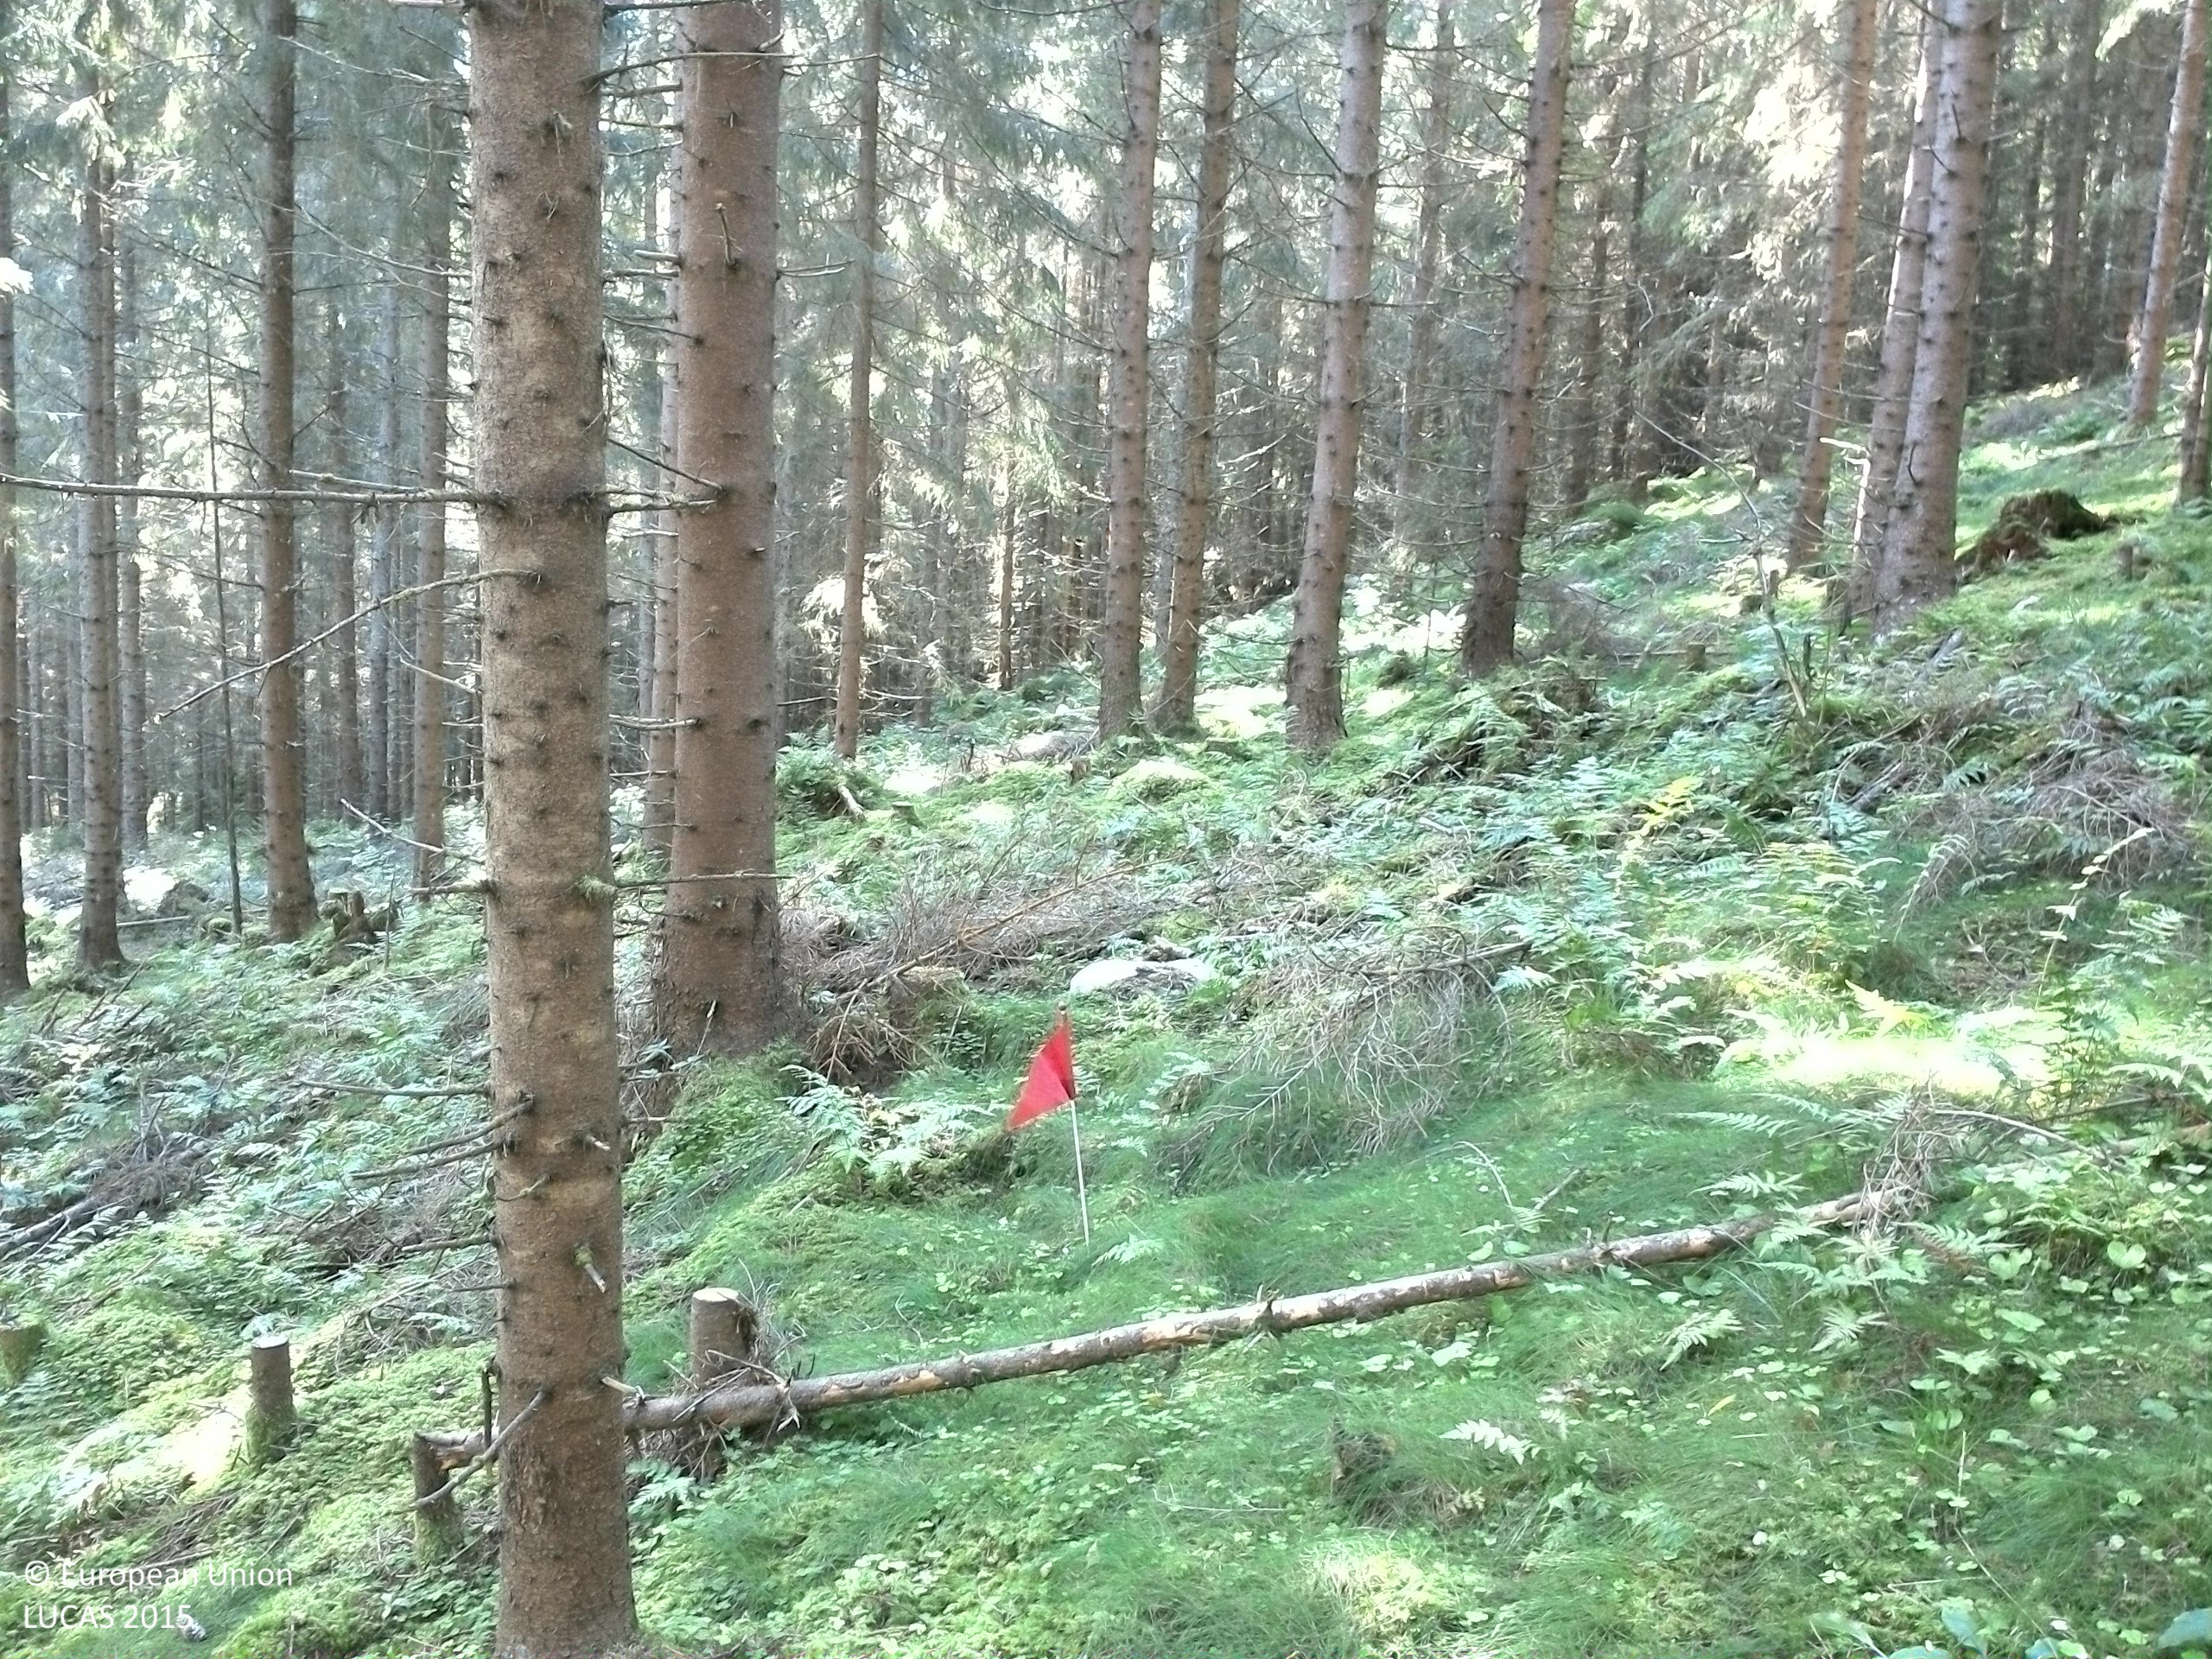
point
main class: Woodland
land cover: Spruce dominated coniferous woodland
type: boreal forest
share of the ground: 50 - 75 %
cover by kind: coniferous forest trees 70 %, lichens and mosses 15 %, shrubs 10 %, herbaceous plants 5 %
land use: Forestry
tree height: > 5 m
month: September
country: SE
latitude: 59.8667
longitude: 13.5092
